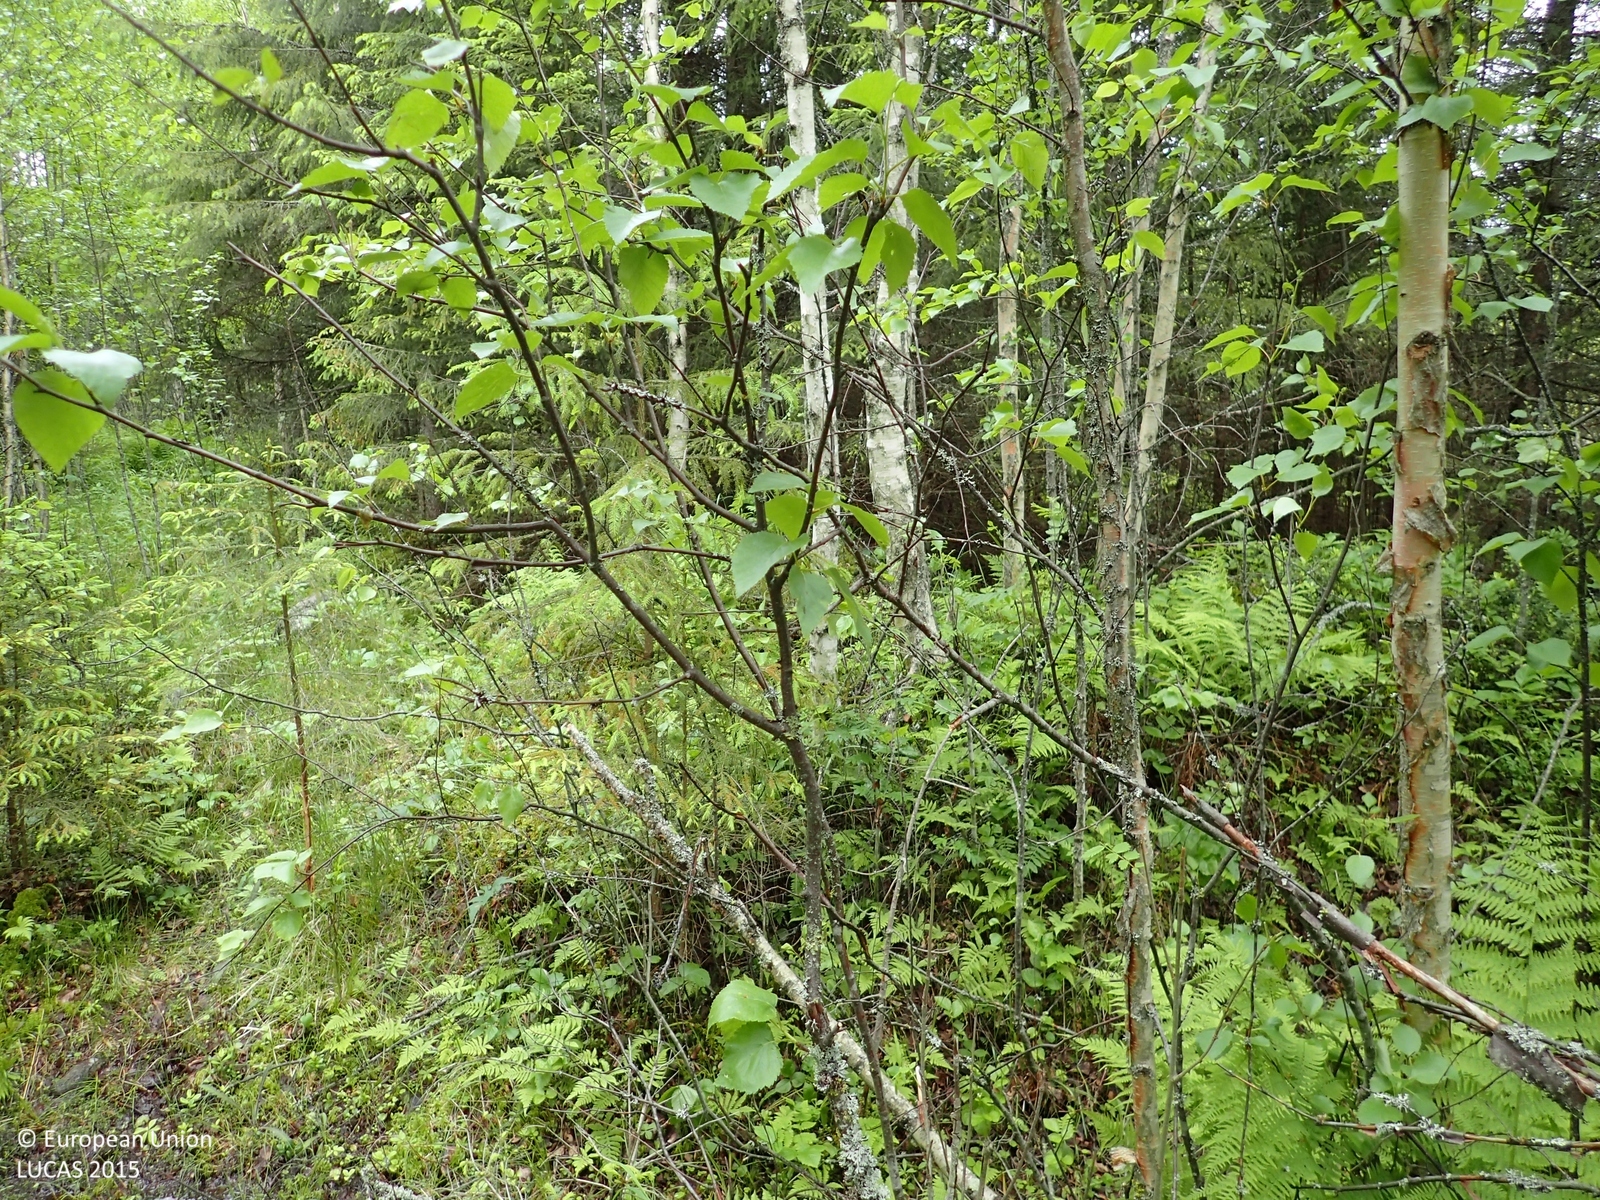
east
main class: Woodland
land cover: Spruce dominated mixed woodland
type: boreal forest
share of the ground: 50 - 75 %
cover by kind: broadleaved forest trees 50 %, herbaceous plants 30 %, coniferous forest trees 20 %
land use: Forestry
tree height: > 5 m
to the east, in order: Spruce dominated mixed woodland; Ditches and canals; Spruce dominated mixed woodland; Other mixed woodland; Spruce dominated mixed woodland
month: June
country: FI
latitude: 62.3942
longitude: 21.6719
